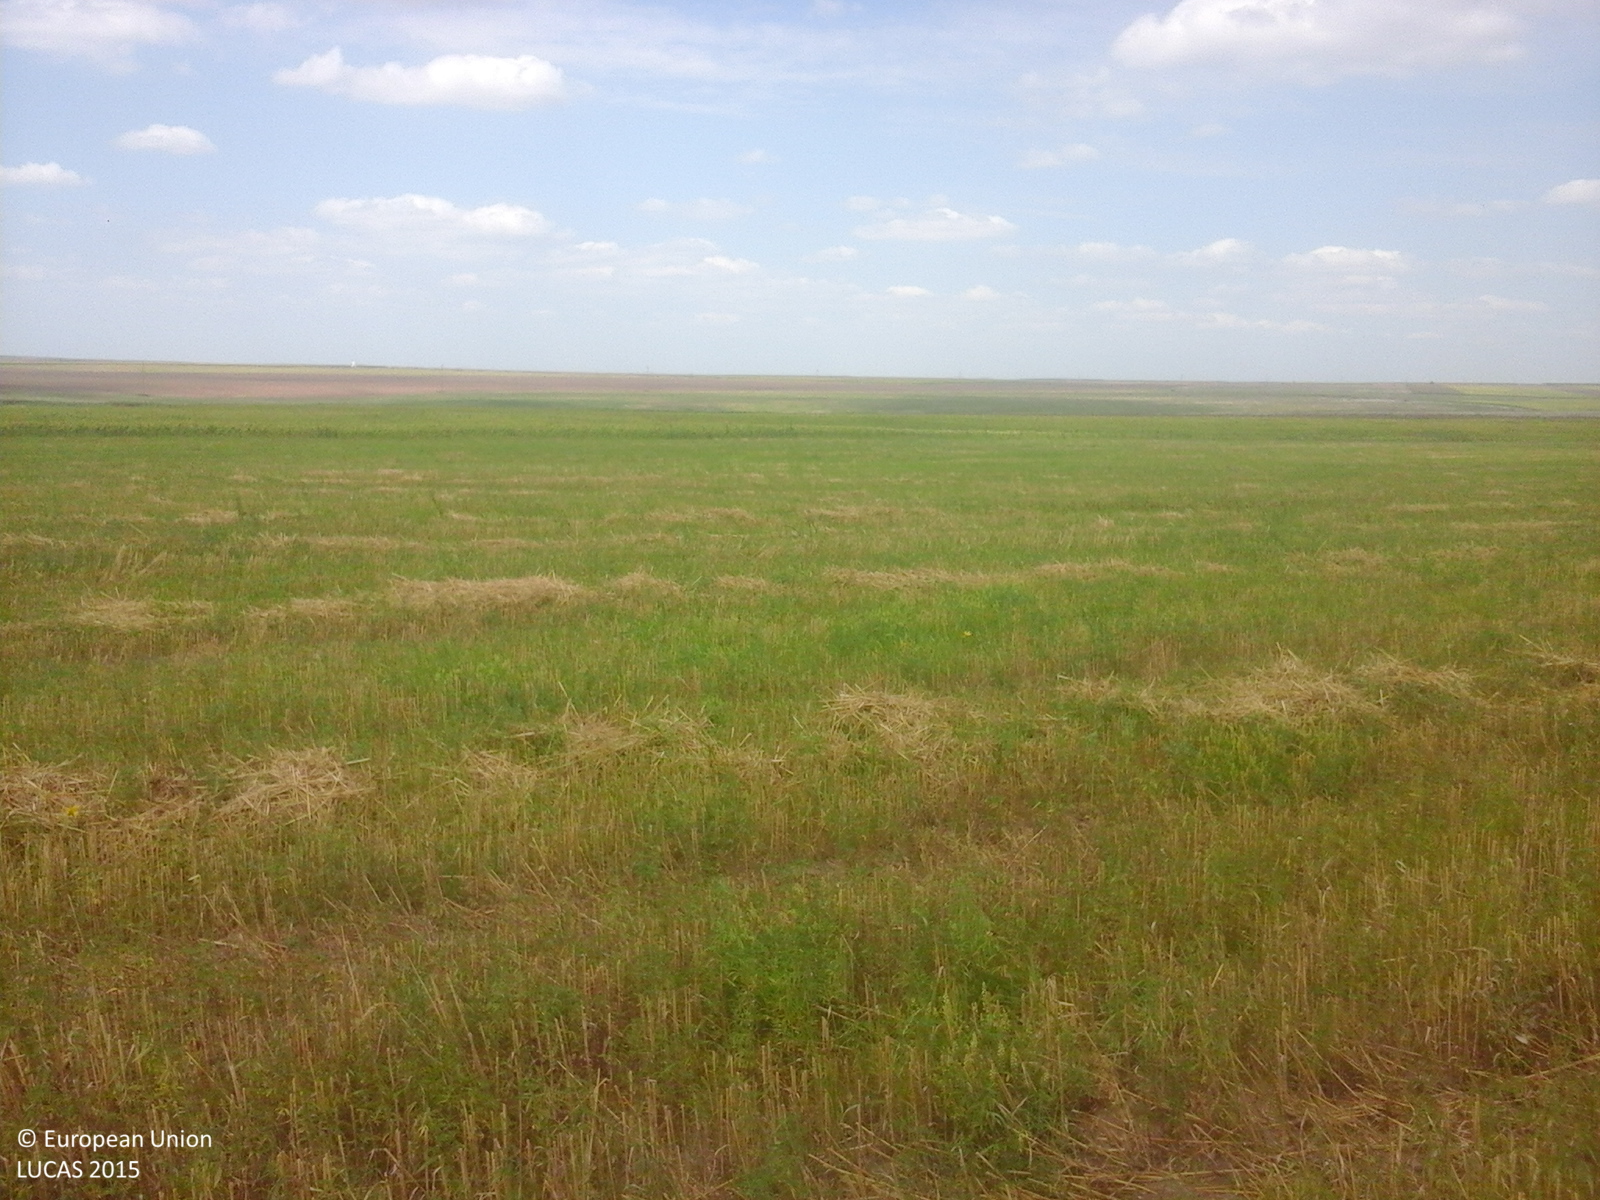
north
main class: Cropland
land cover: Common wheat
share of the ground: 25 - 50 %
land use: Agriculture (excluding fallow land and kitchen gardens)
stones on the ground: < 10 %
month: August
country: RO
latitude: 44.7727
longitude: 28.1989
